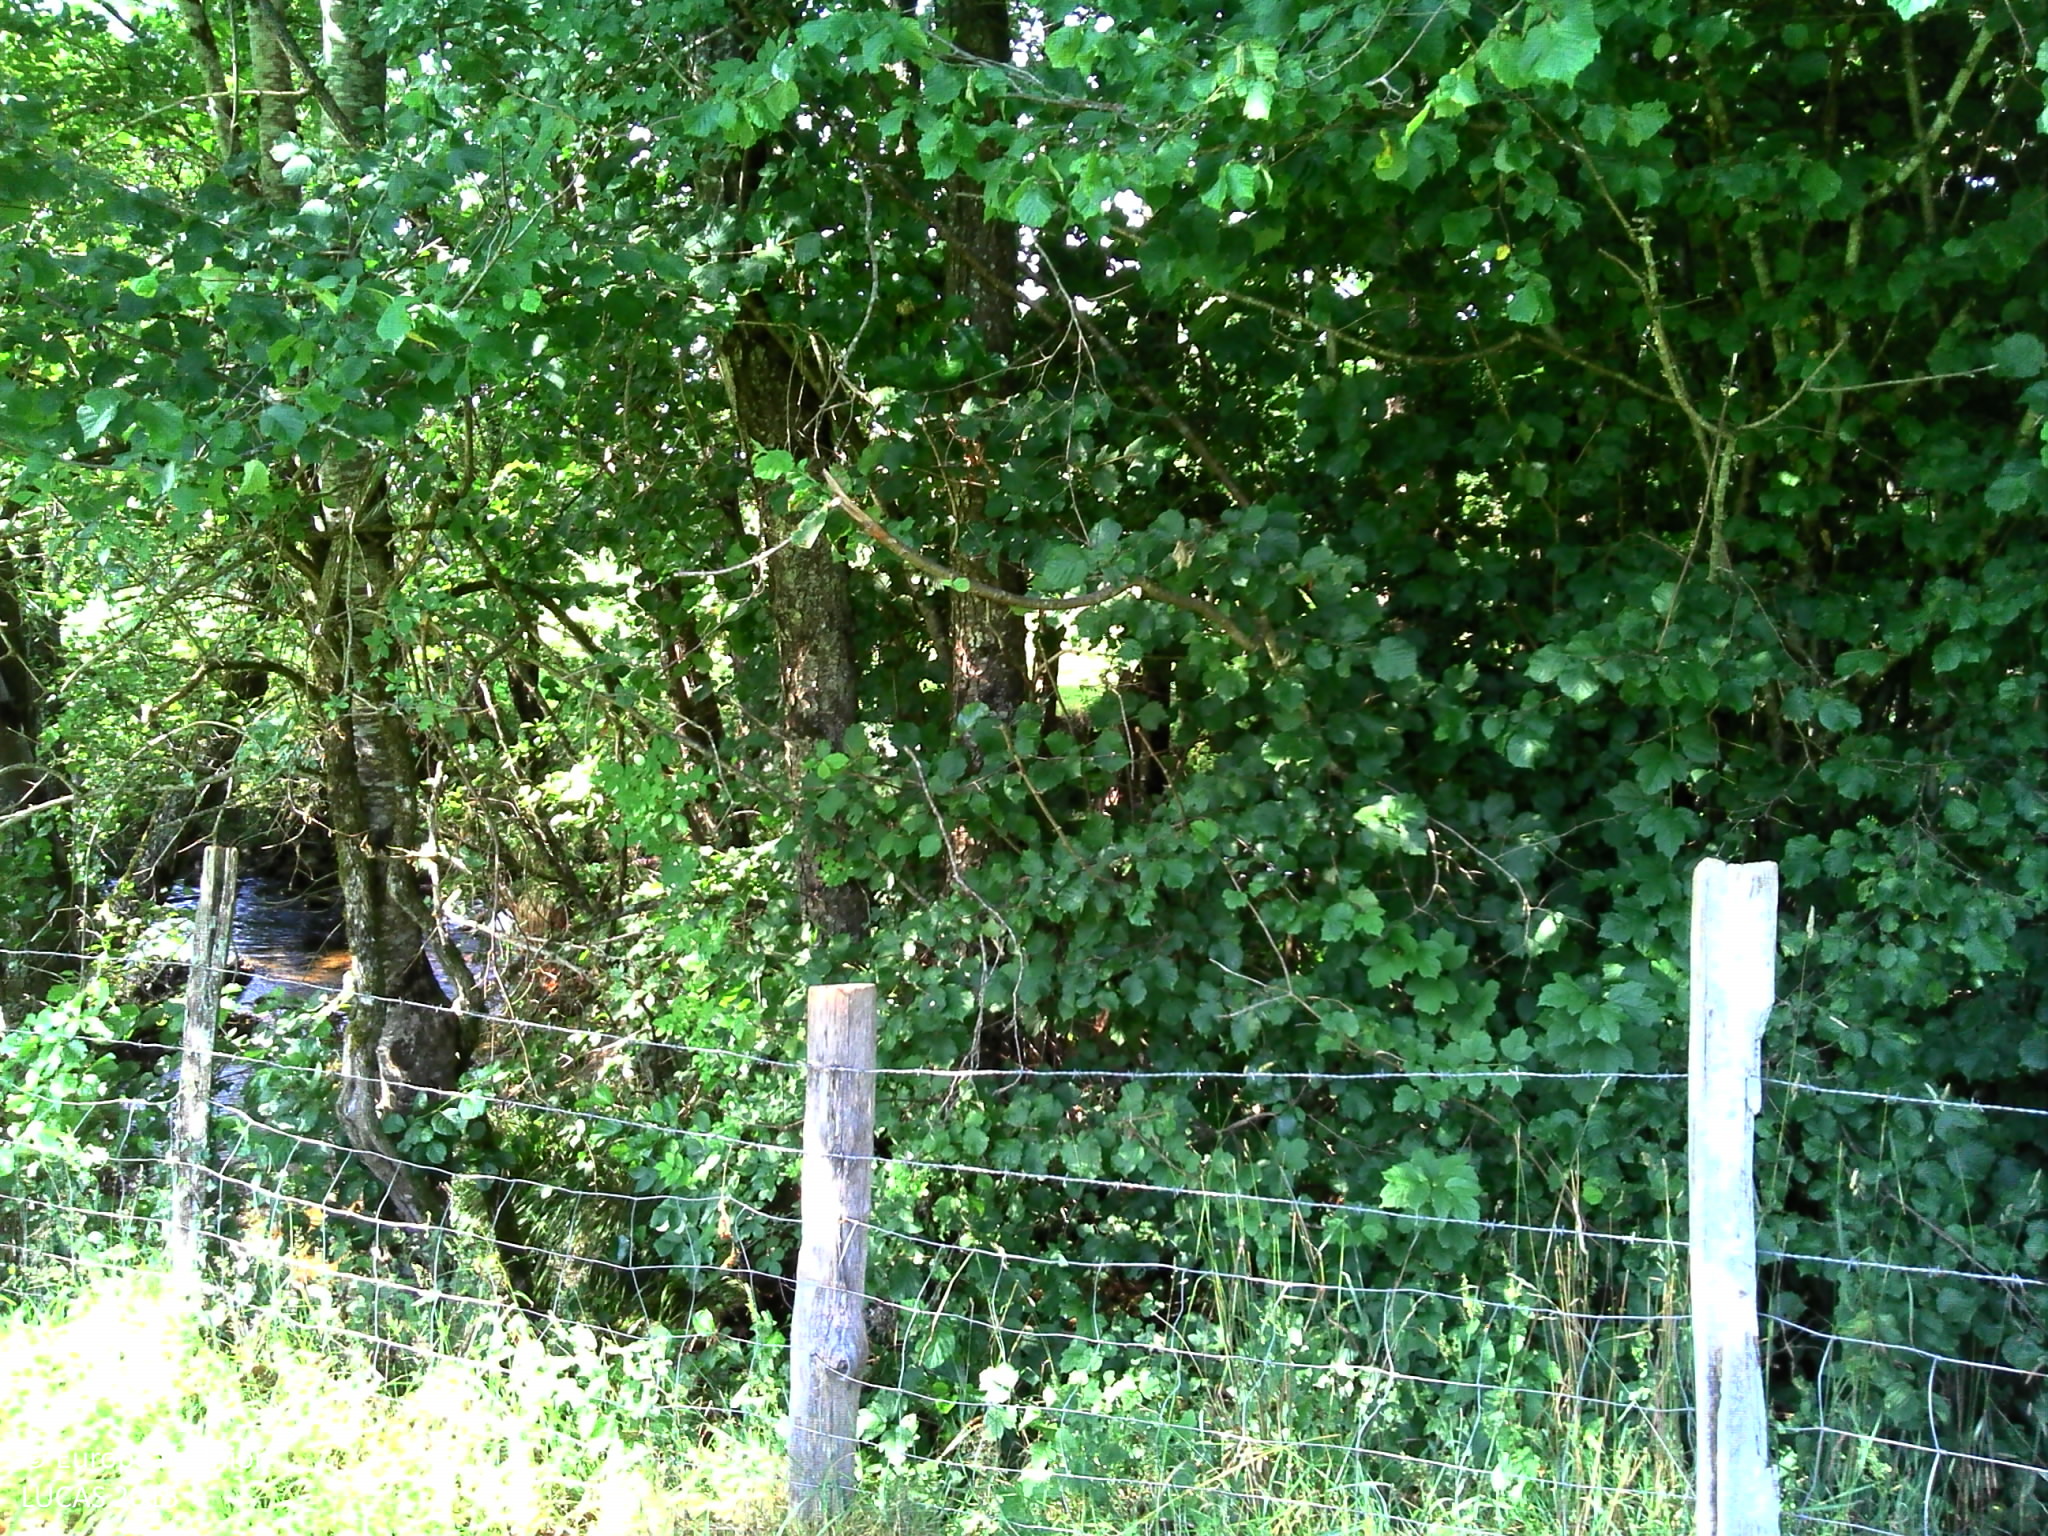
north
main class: Grassland
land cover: Grassland without tree/shrub cover
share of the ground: > 75 %
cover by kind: herbaceous plants 95 %
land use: Agriculture (excluding fallow land and kitchen gardens)
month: July
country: FR
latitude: 45.6912
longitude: 1.7889
